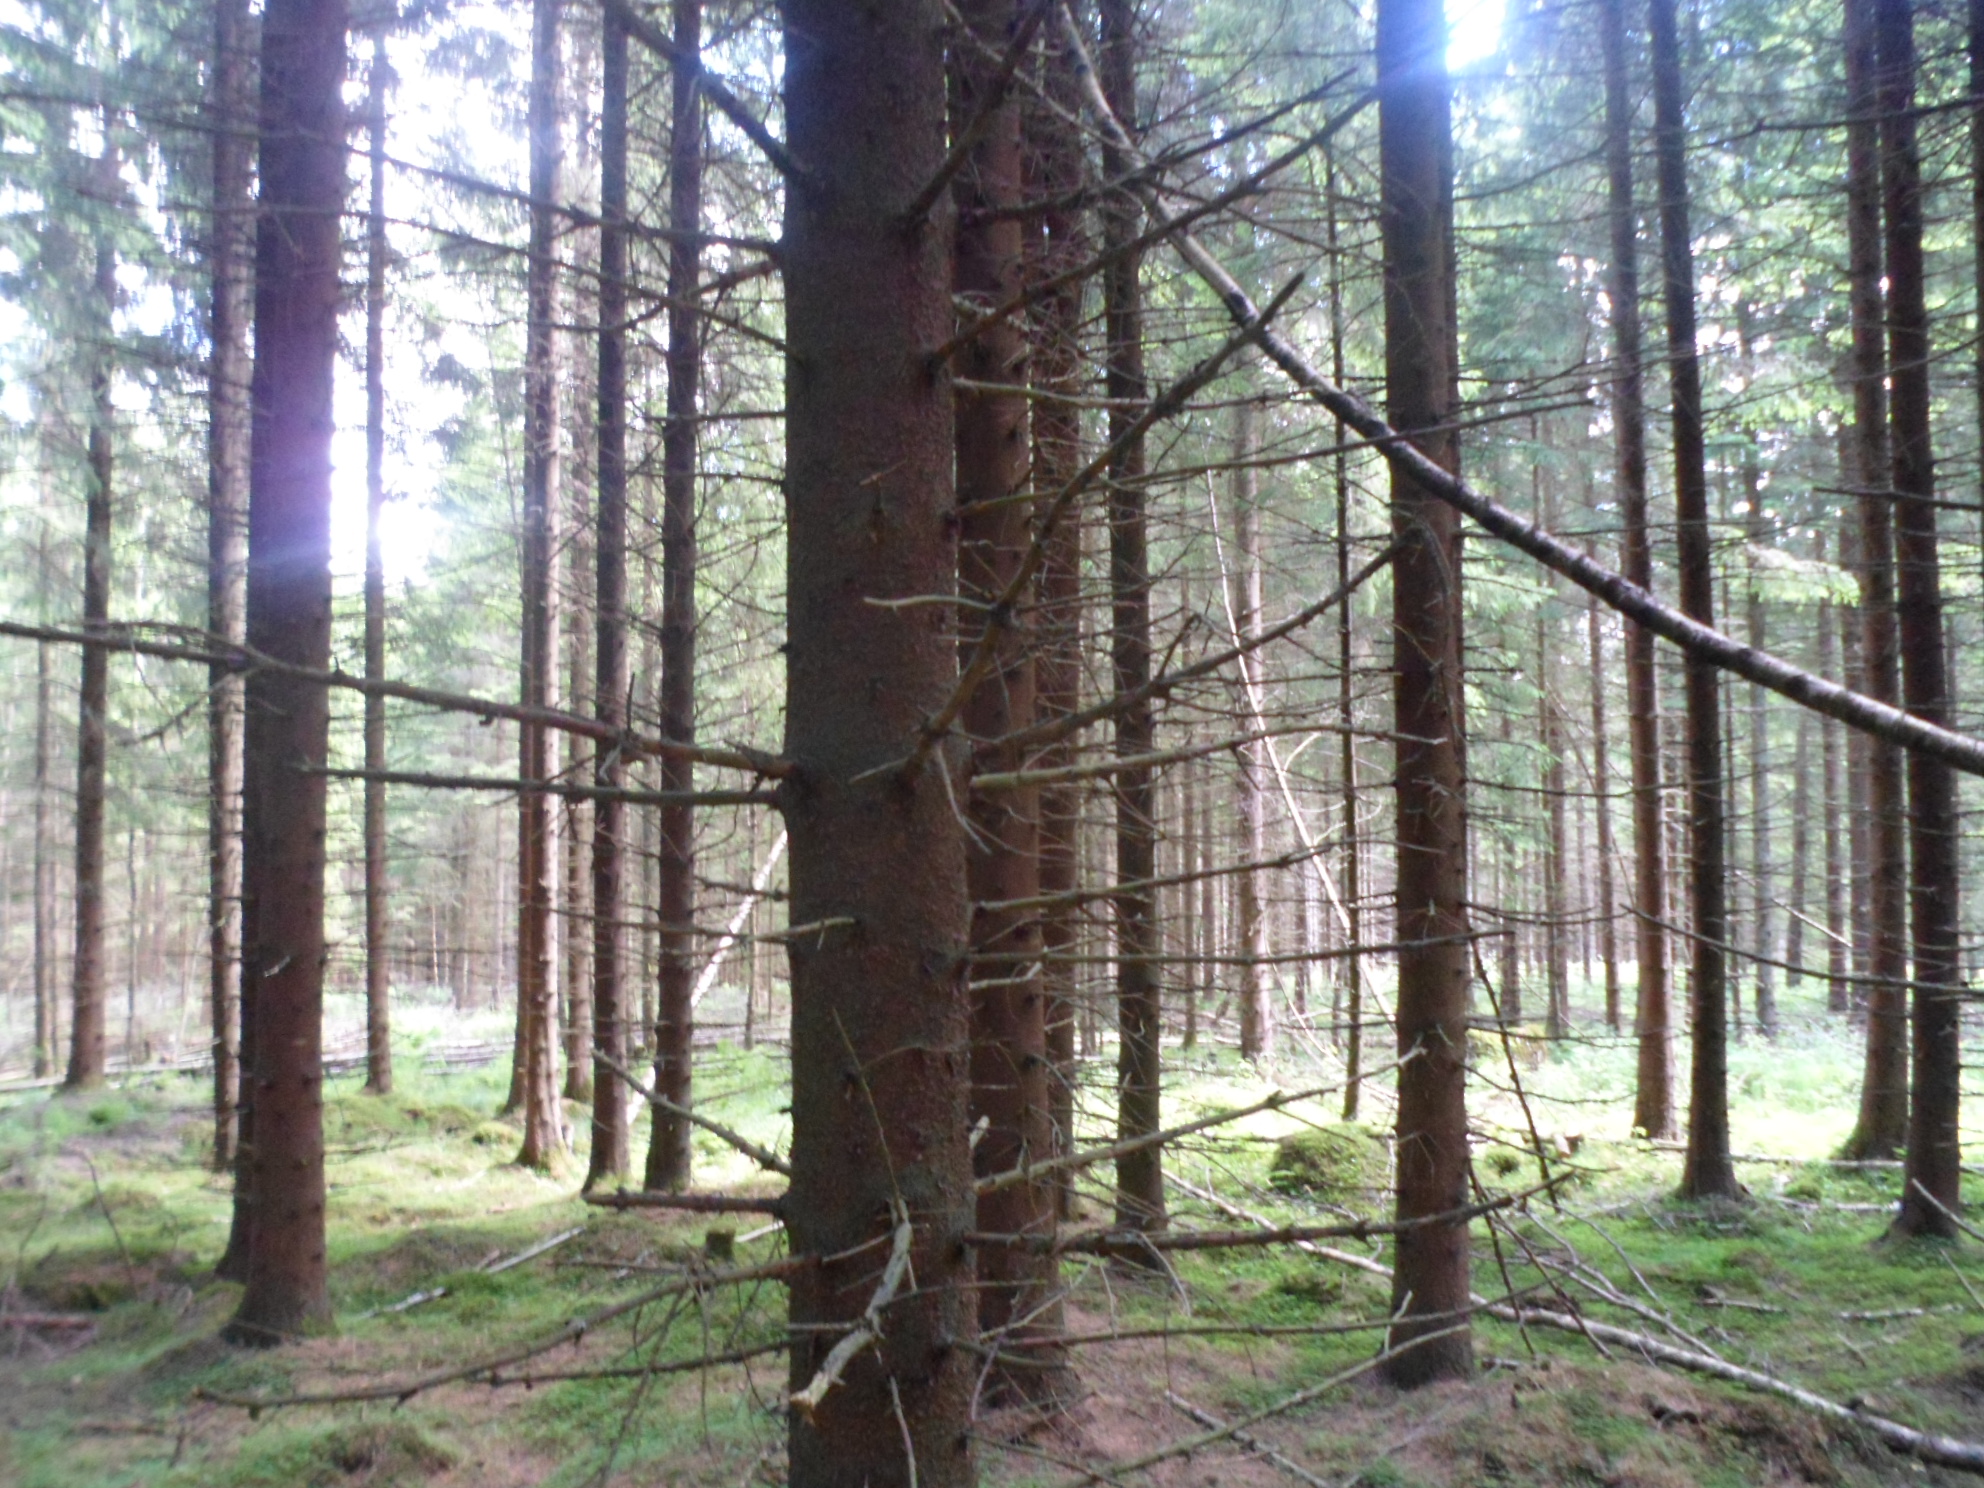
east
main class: Woodland
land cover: Spruce dominated coniferous woodland
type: boreal forest
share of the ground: > 75 %
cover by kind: coniferous forest trees 80 %, herbaceous plants 10 %, lichens and mosses 5 %, unconsolidated bare surface 5 %
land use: Forestry
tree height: > 5 m
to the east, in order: Spruce dominated coniferous woodland; Tracks; Spruce dominated coniferous woodland
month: July
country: SE
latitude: 57.4413
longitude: 14.5108
